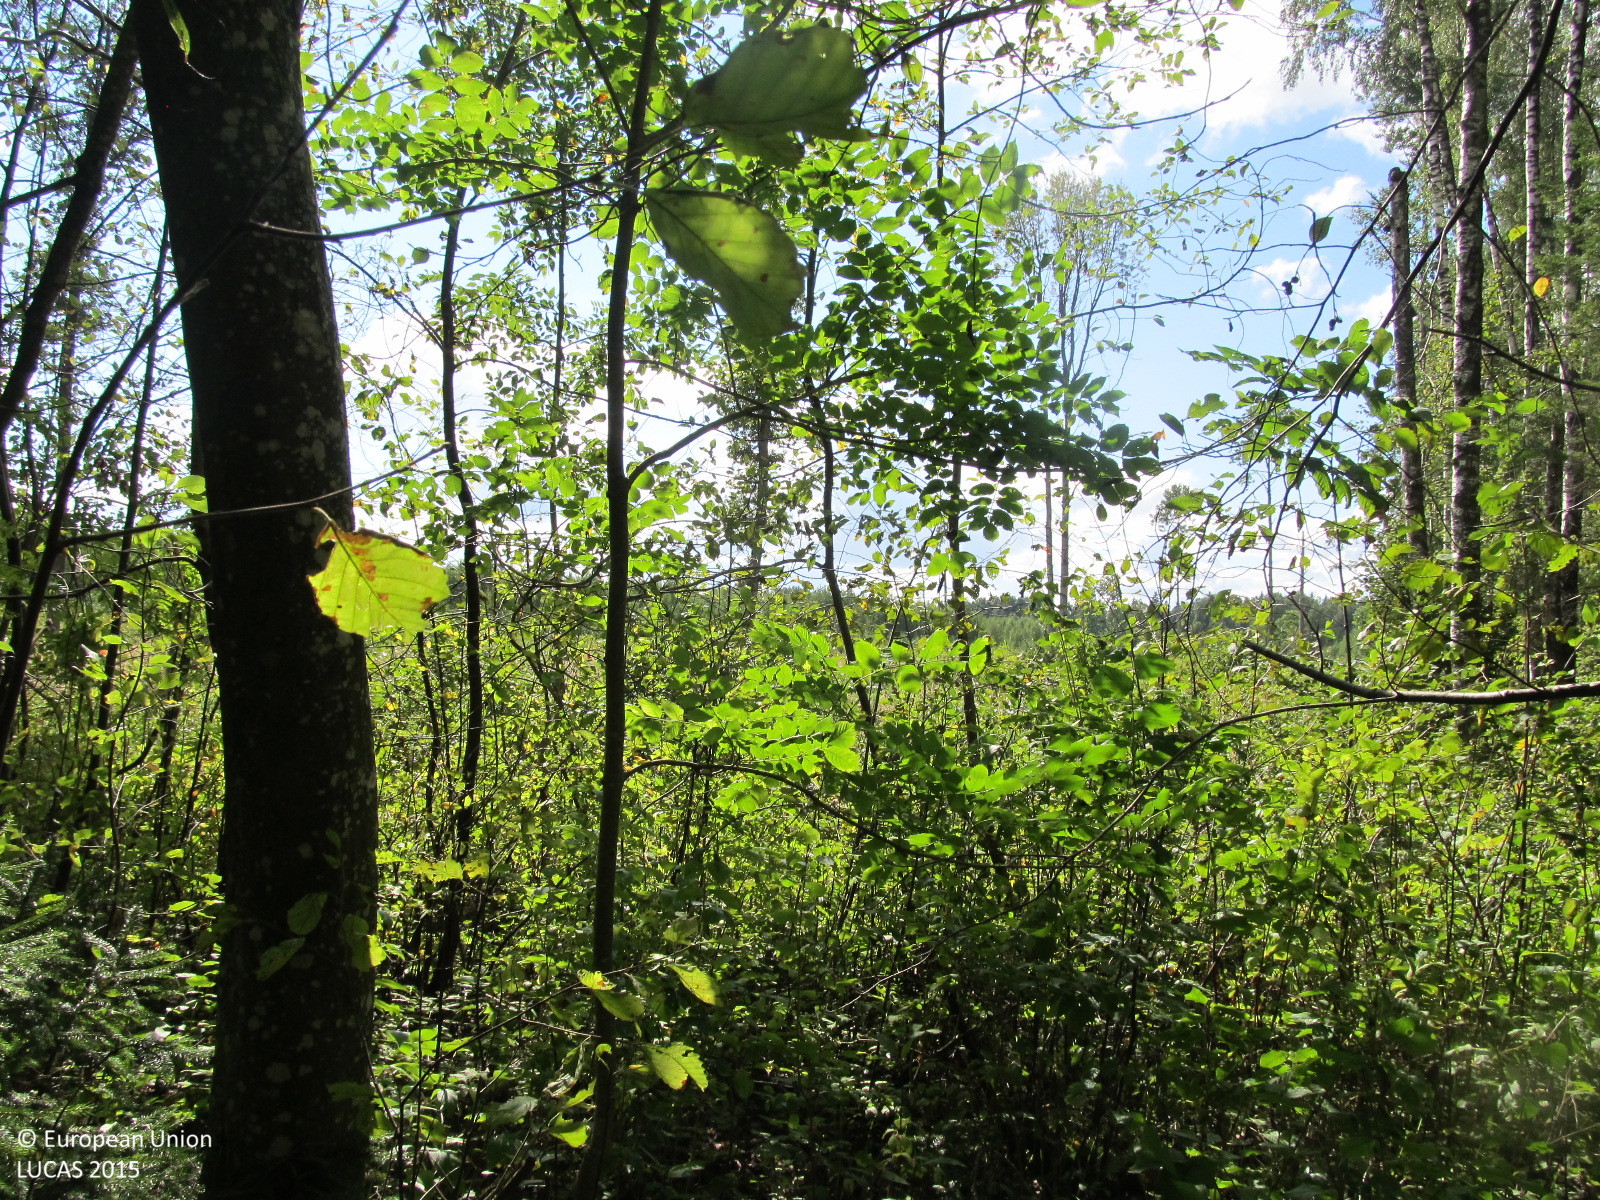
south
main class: Woodland
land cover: Broadleaved woodland
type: non-riverine alder, birch or aspen forest
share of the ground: > 75 %
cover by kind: broadleaved forest trees 75 %, shrubs 10 %, herbaceous plants 10 %, coniferous forest trees 5 %
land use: Forestry
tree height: > 5 m
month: September
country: LT
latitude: 56.0725
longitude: 23.3271
